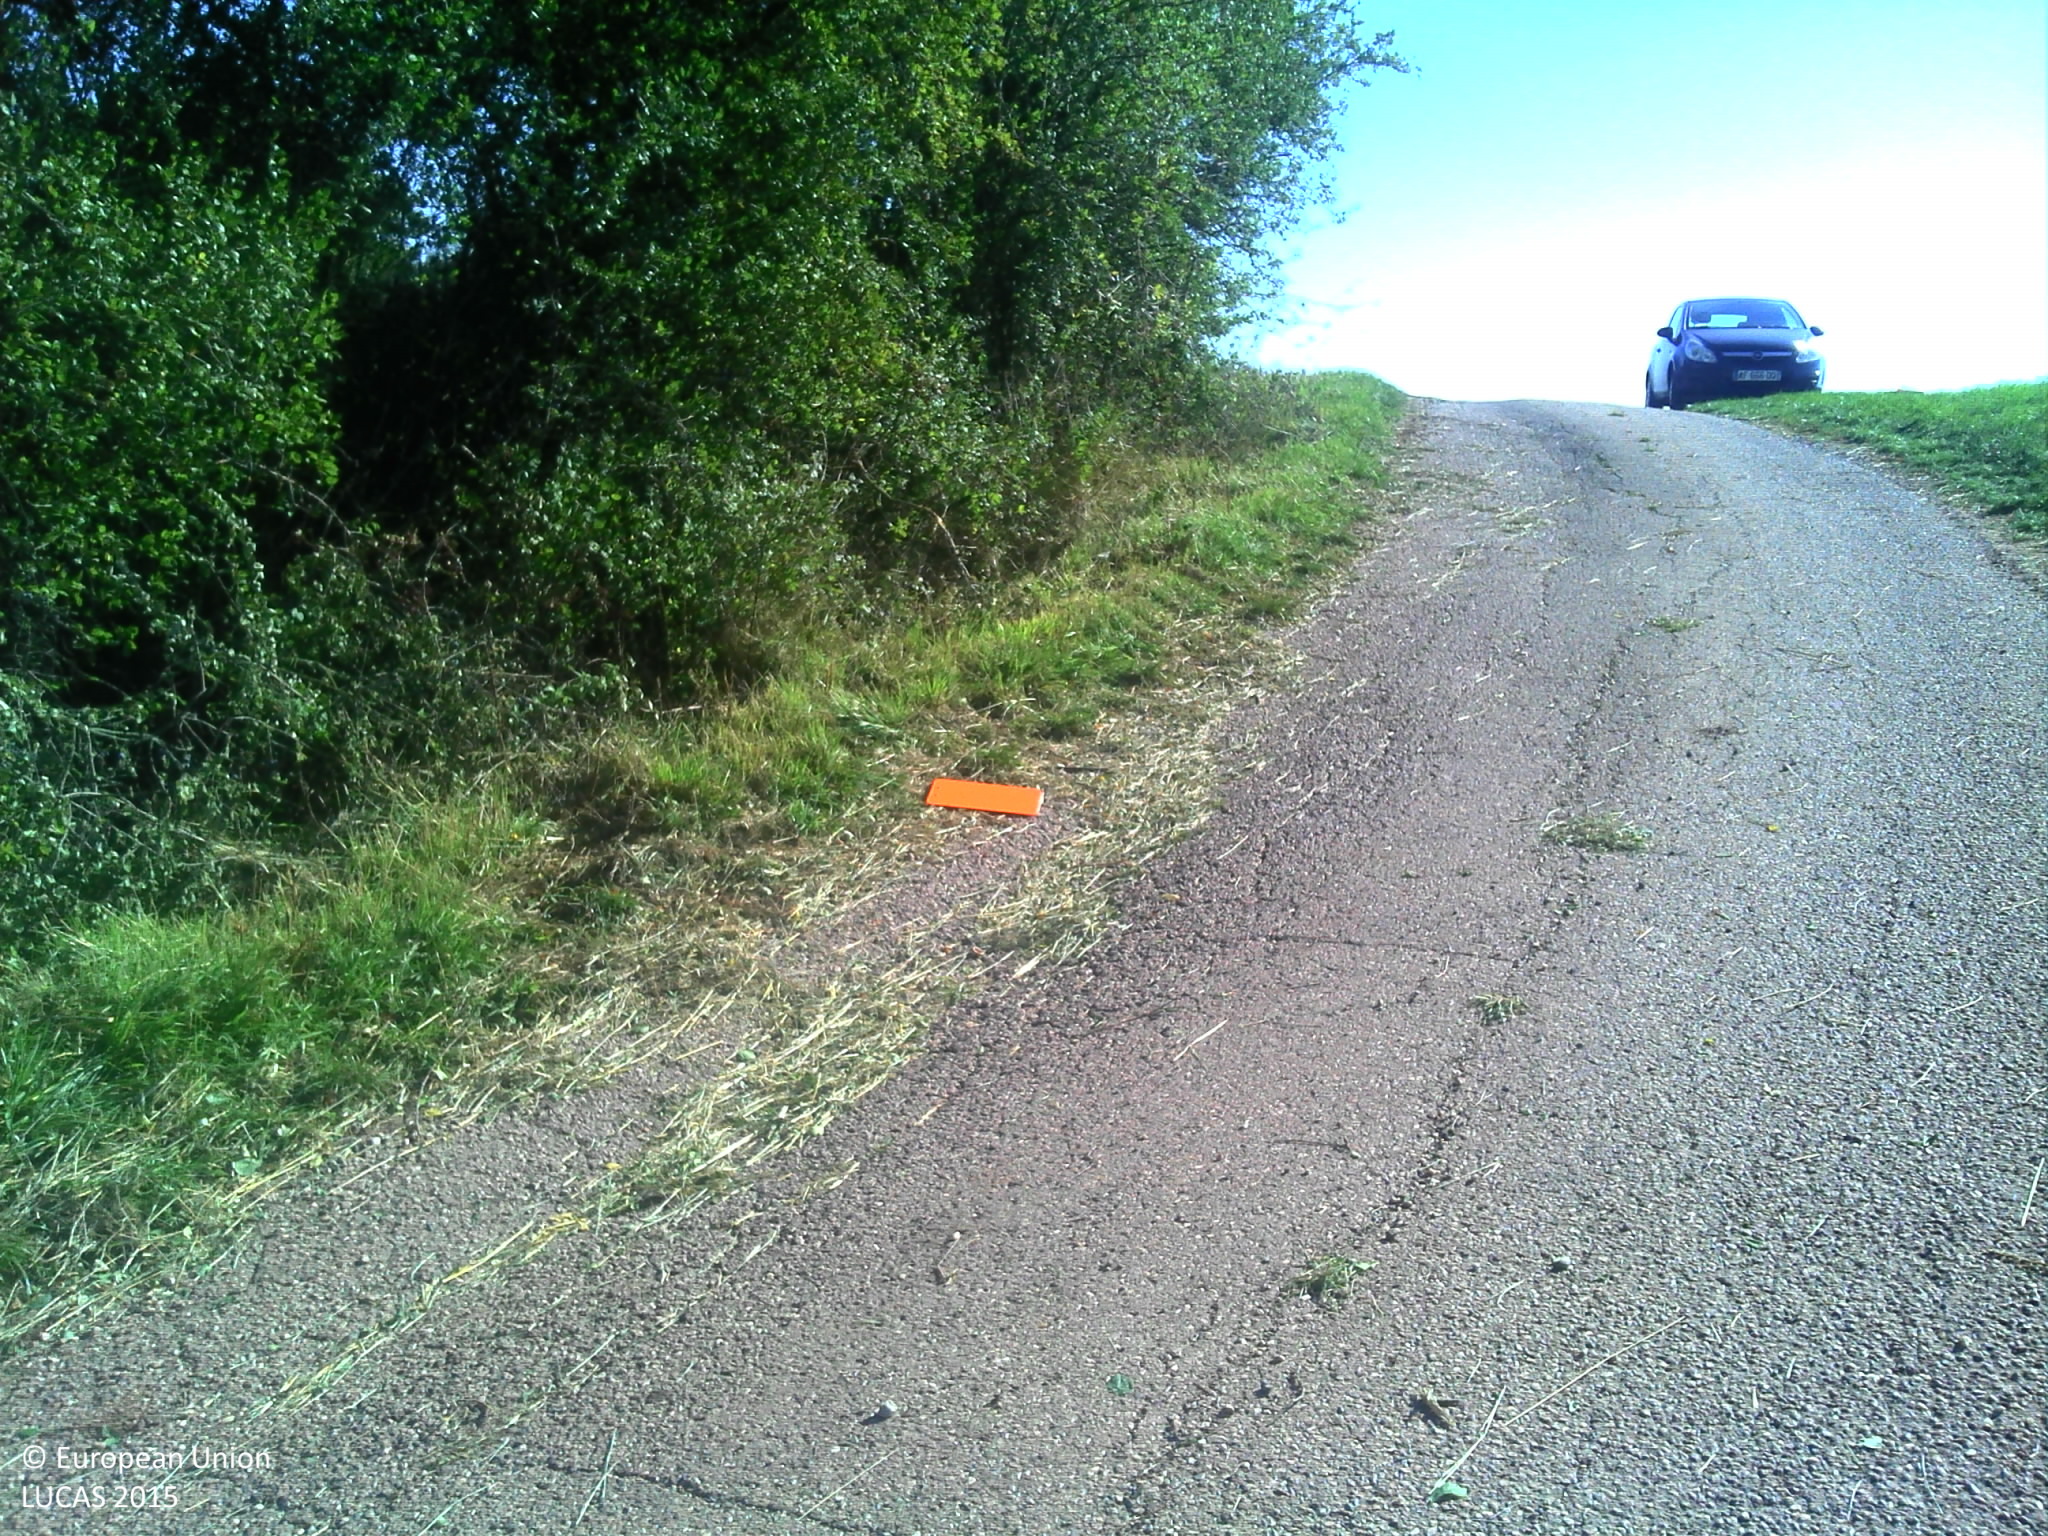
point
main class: Woodland
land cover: Broadleaved woodland
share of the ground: > 75 %
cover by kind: broadleaved forest trees 60 %, shrubs 30 %, herbaceous plants 10 %
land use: Semi-natural and natural areas not in use
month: October
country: FR
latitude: 48.7436
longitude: 6.4781
